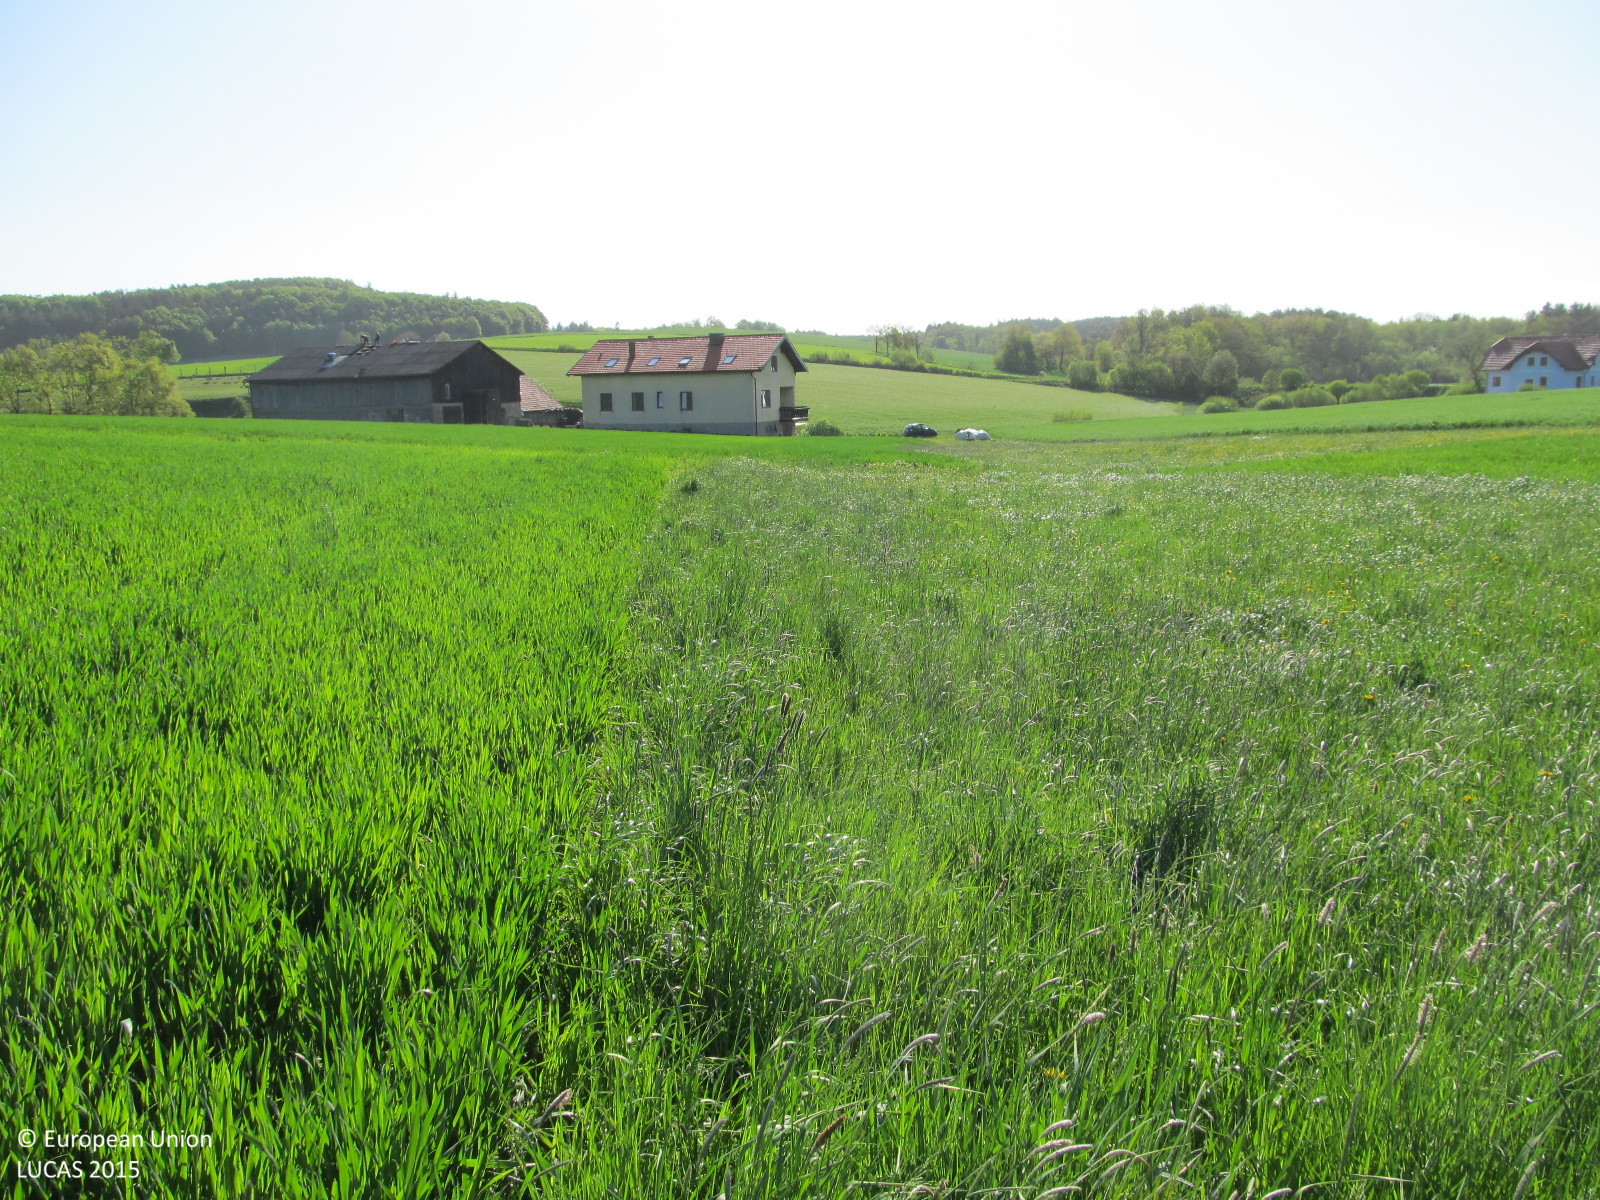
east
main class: Grassland
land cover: Grassland without tree/shrub cover
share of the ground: > 75 %
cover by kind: herbaceous plants 100 %
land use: Agriculture (excluding fallow land and kitchen gardens)
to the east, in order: Grassland without tree/shrub cover; Common wheat; Grassland without tree/shrub cover; Artificial constructions in urban areas; Other bare soil; Grassland without tree/shrub cover; Rivers and streams; Grassland without tree/shrub cover; Common wheat
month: May
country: AT
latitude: 48.5377
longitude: 15.4880
